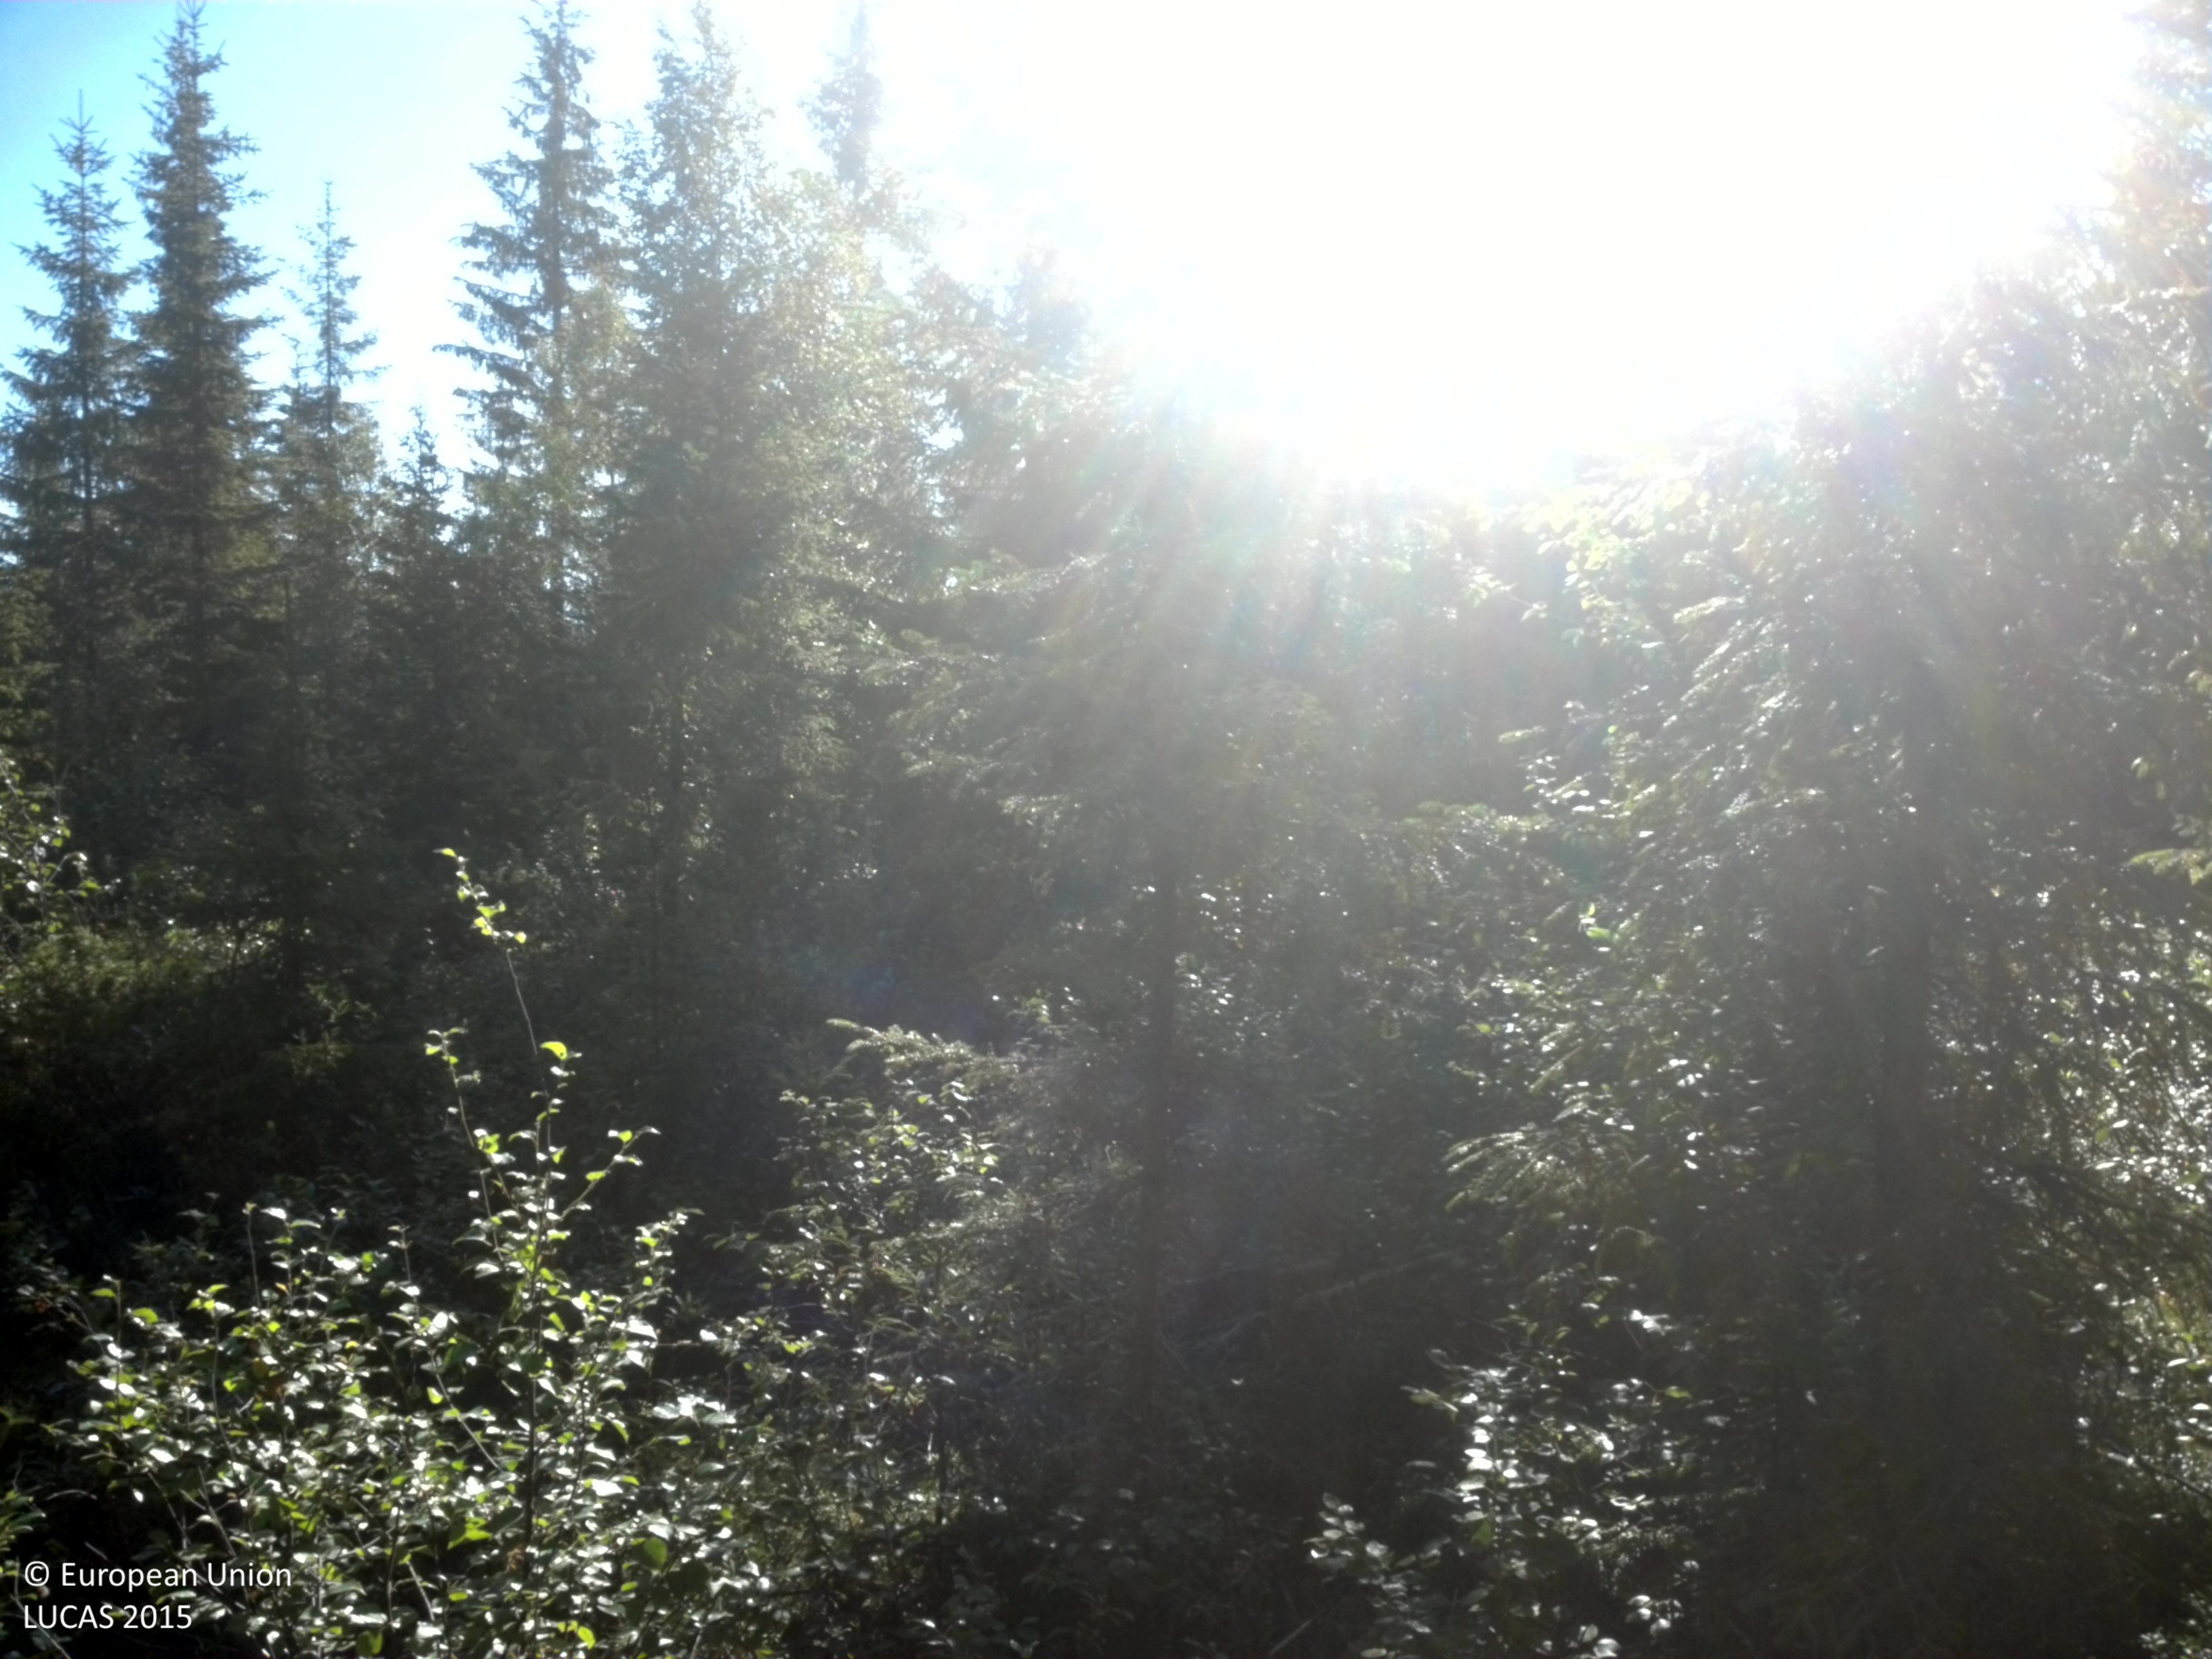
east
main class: Woodland
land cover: Spruce dominated mixed woodland
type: boreal forest
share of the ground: > 75 %
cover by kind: coniferous forest trees 60 %, broadleaved forest trees 20 %, shrubs 15 %, lichens and mosses 5 %
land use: Forestry
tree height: > 5 m
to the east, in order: Spruce dominated mixed woodland; Peatbogs
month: August
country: SE
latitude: 64.4468
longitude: 18.4253
